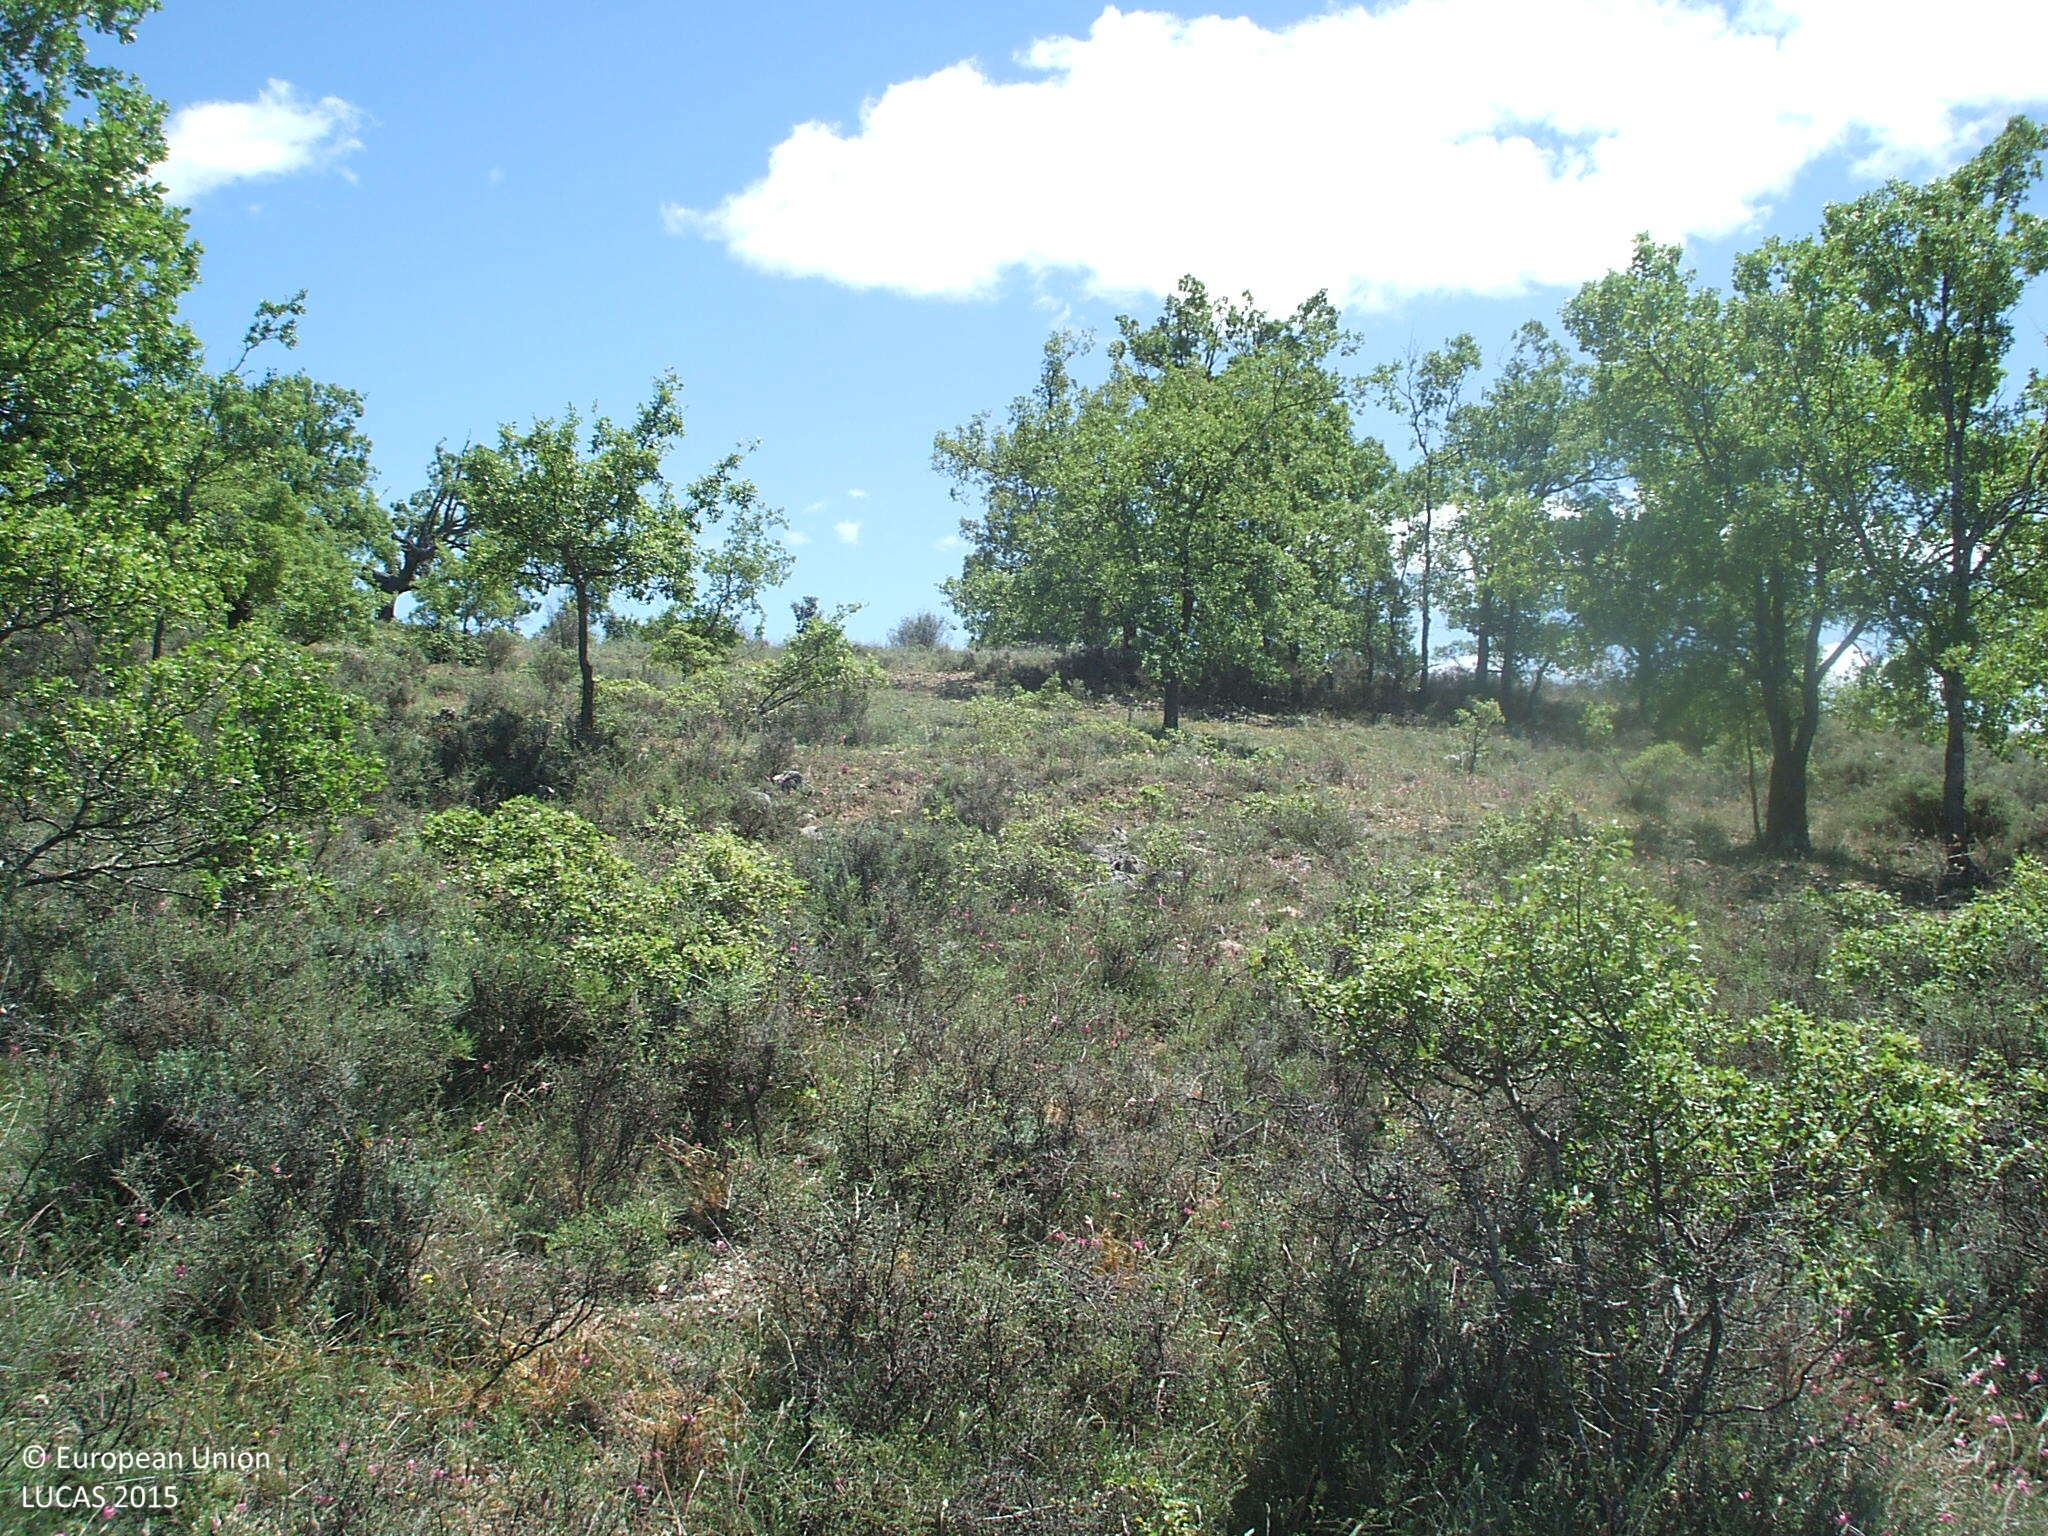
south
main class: Woodland
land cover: Broadleaved woodland
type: broadleaved evergreen forest
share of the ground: 25 - 50 %
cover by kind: broadleaved forest trees 30 %, unconsolidated bare surface 30 %, shrubs 20 %, herbaceous plants 20 %
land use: Semi-natural and natural areas not in use
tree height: > 5 m
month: May
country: ES
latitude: 40.9808
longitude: -2.9300
